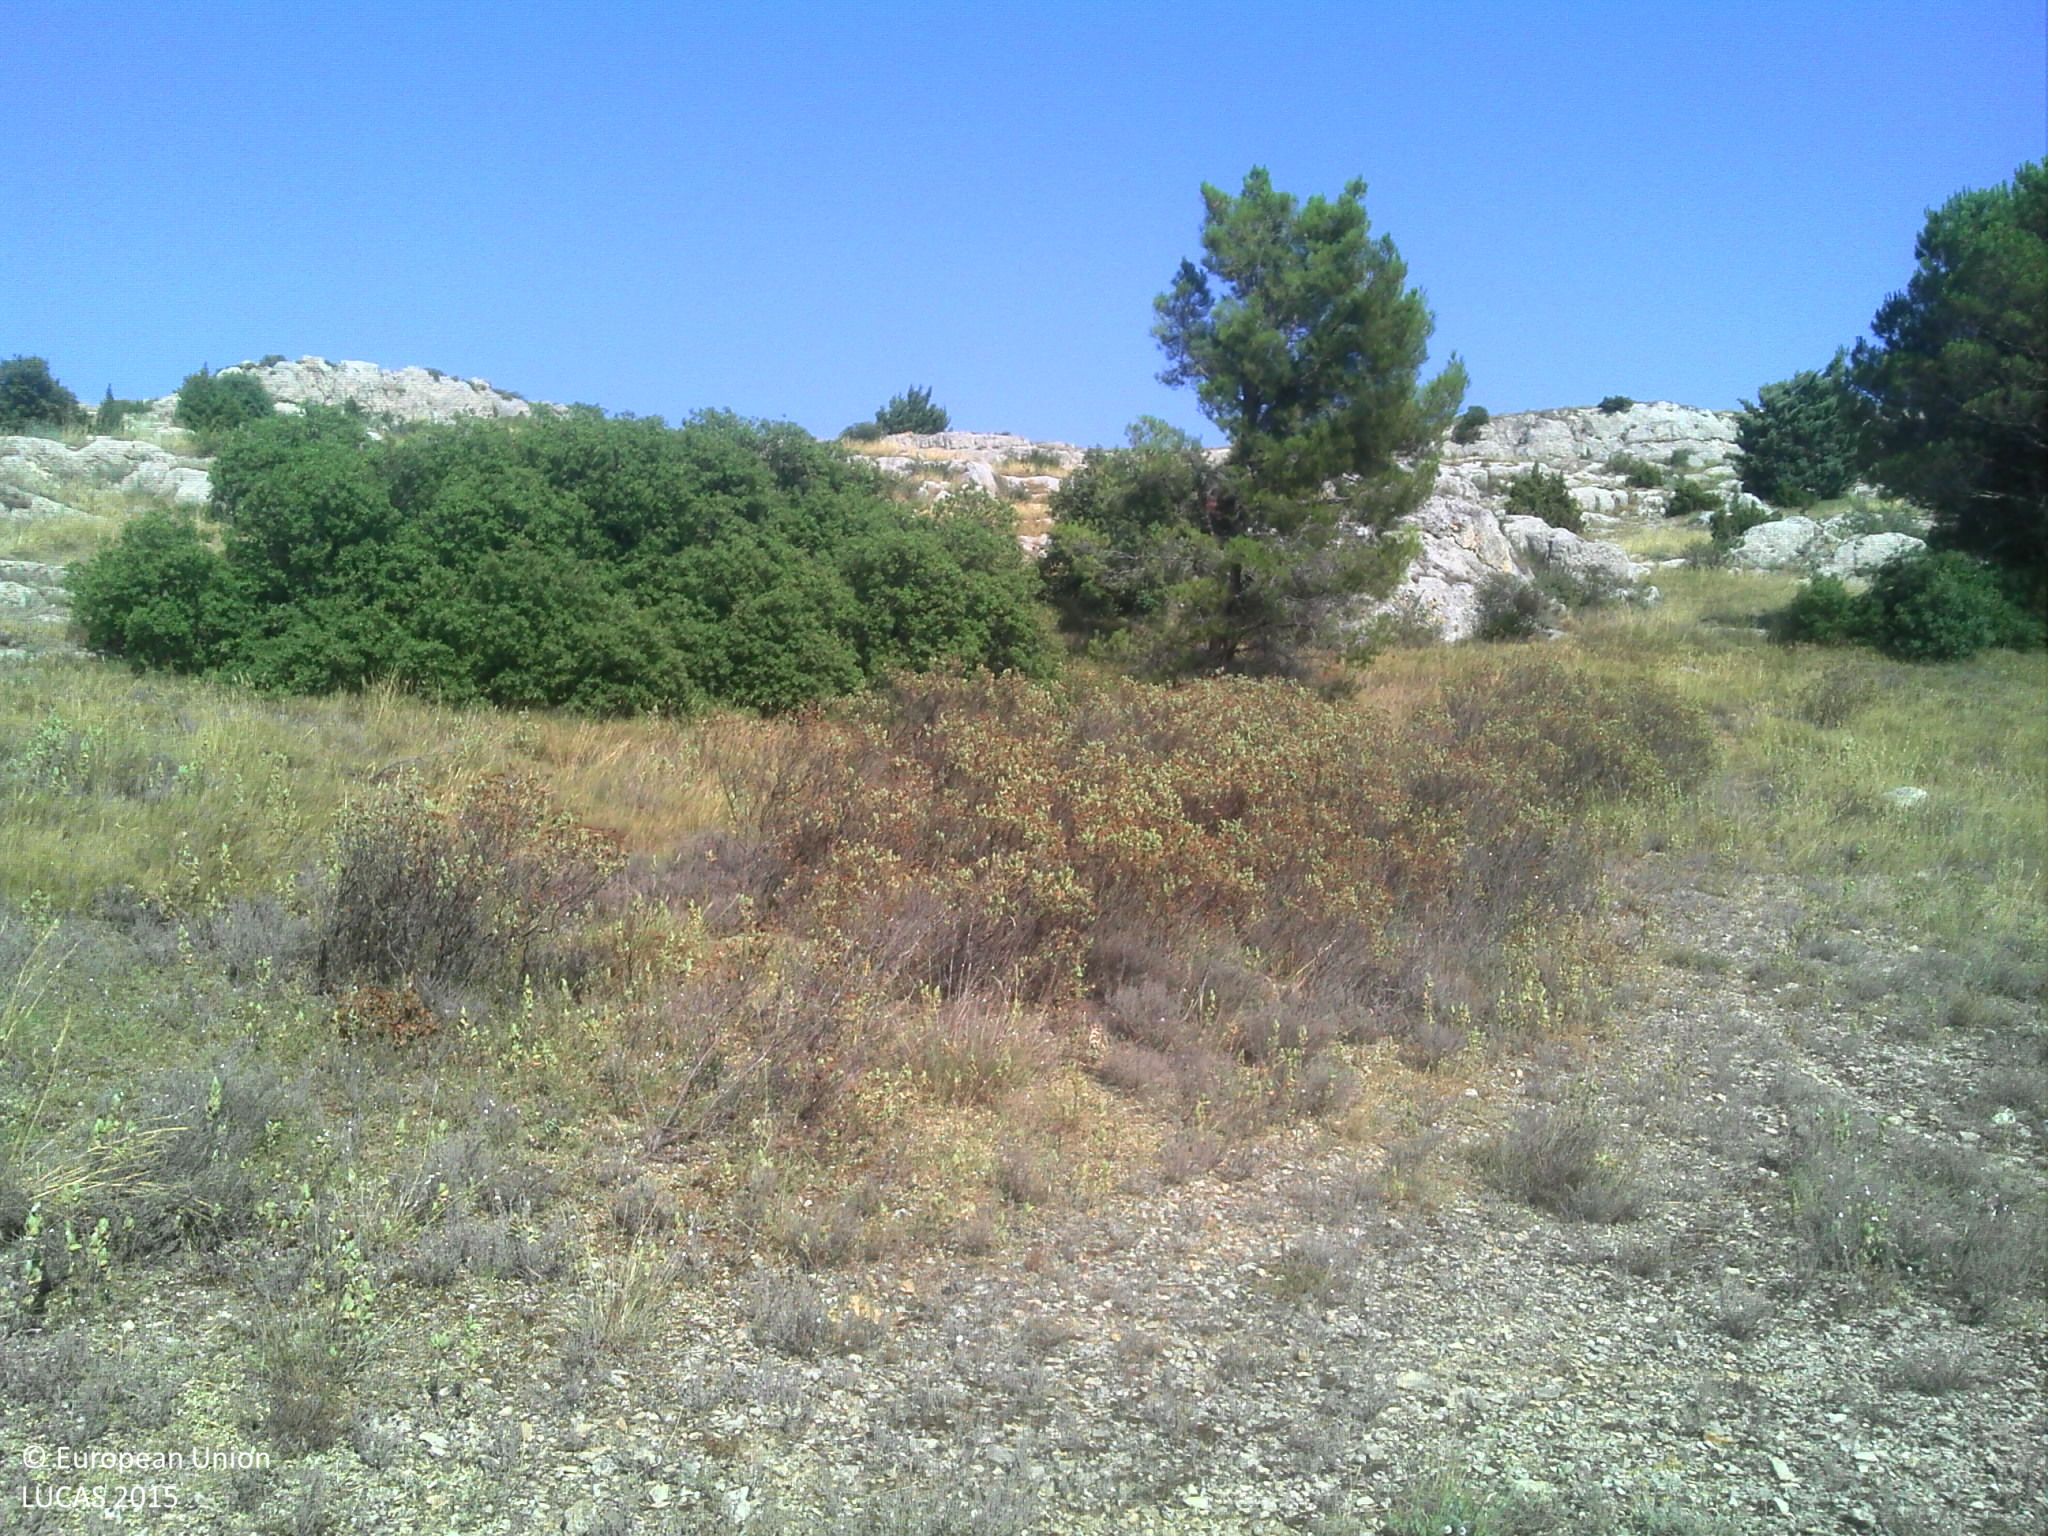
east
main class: Grassland
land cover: Grassland with sparse tree/shrub cover
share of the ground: 50 - 75 %
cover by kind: herbaceous plants 40 %, unconsolidated bare surface 40 %, lichens and mosses 10 %, broadleaved forest trees 5 %, shrubs 5 %
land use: Semi-natural and natural areas not in use
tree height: > 5 m
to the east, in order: Grassland with sparse tree/shrub cover; Rocks and stones; Spontaneously vegetated surfaces; Rock outcrops; Shrubland without tree cover; Rock outcrops; Shrubland without tree cover; Rock outcrops; Shrubland without tree cover; Rock outcrops; Shrubland with sparse tree cover; Shrubland without tree cover; Rocks and stones; Spontaneously vegetated surfaces; Single bushes/trees; Rocks and stones; Spontaneously vegetated surfaces; Rock outcrops; Broadleaved woodland; Rock outcrops; Shrubland with sparse tree cover; Rock outcrops; Rocks and stones; Shrubland with sparse tree cover; Spontaneously vegetated surfaces; Pine dominated mixed woodland; Rock outcrops; Shrubland without tree cover
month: July
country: FR
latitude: 43.7291
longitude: 5.1055
